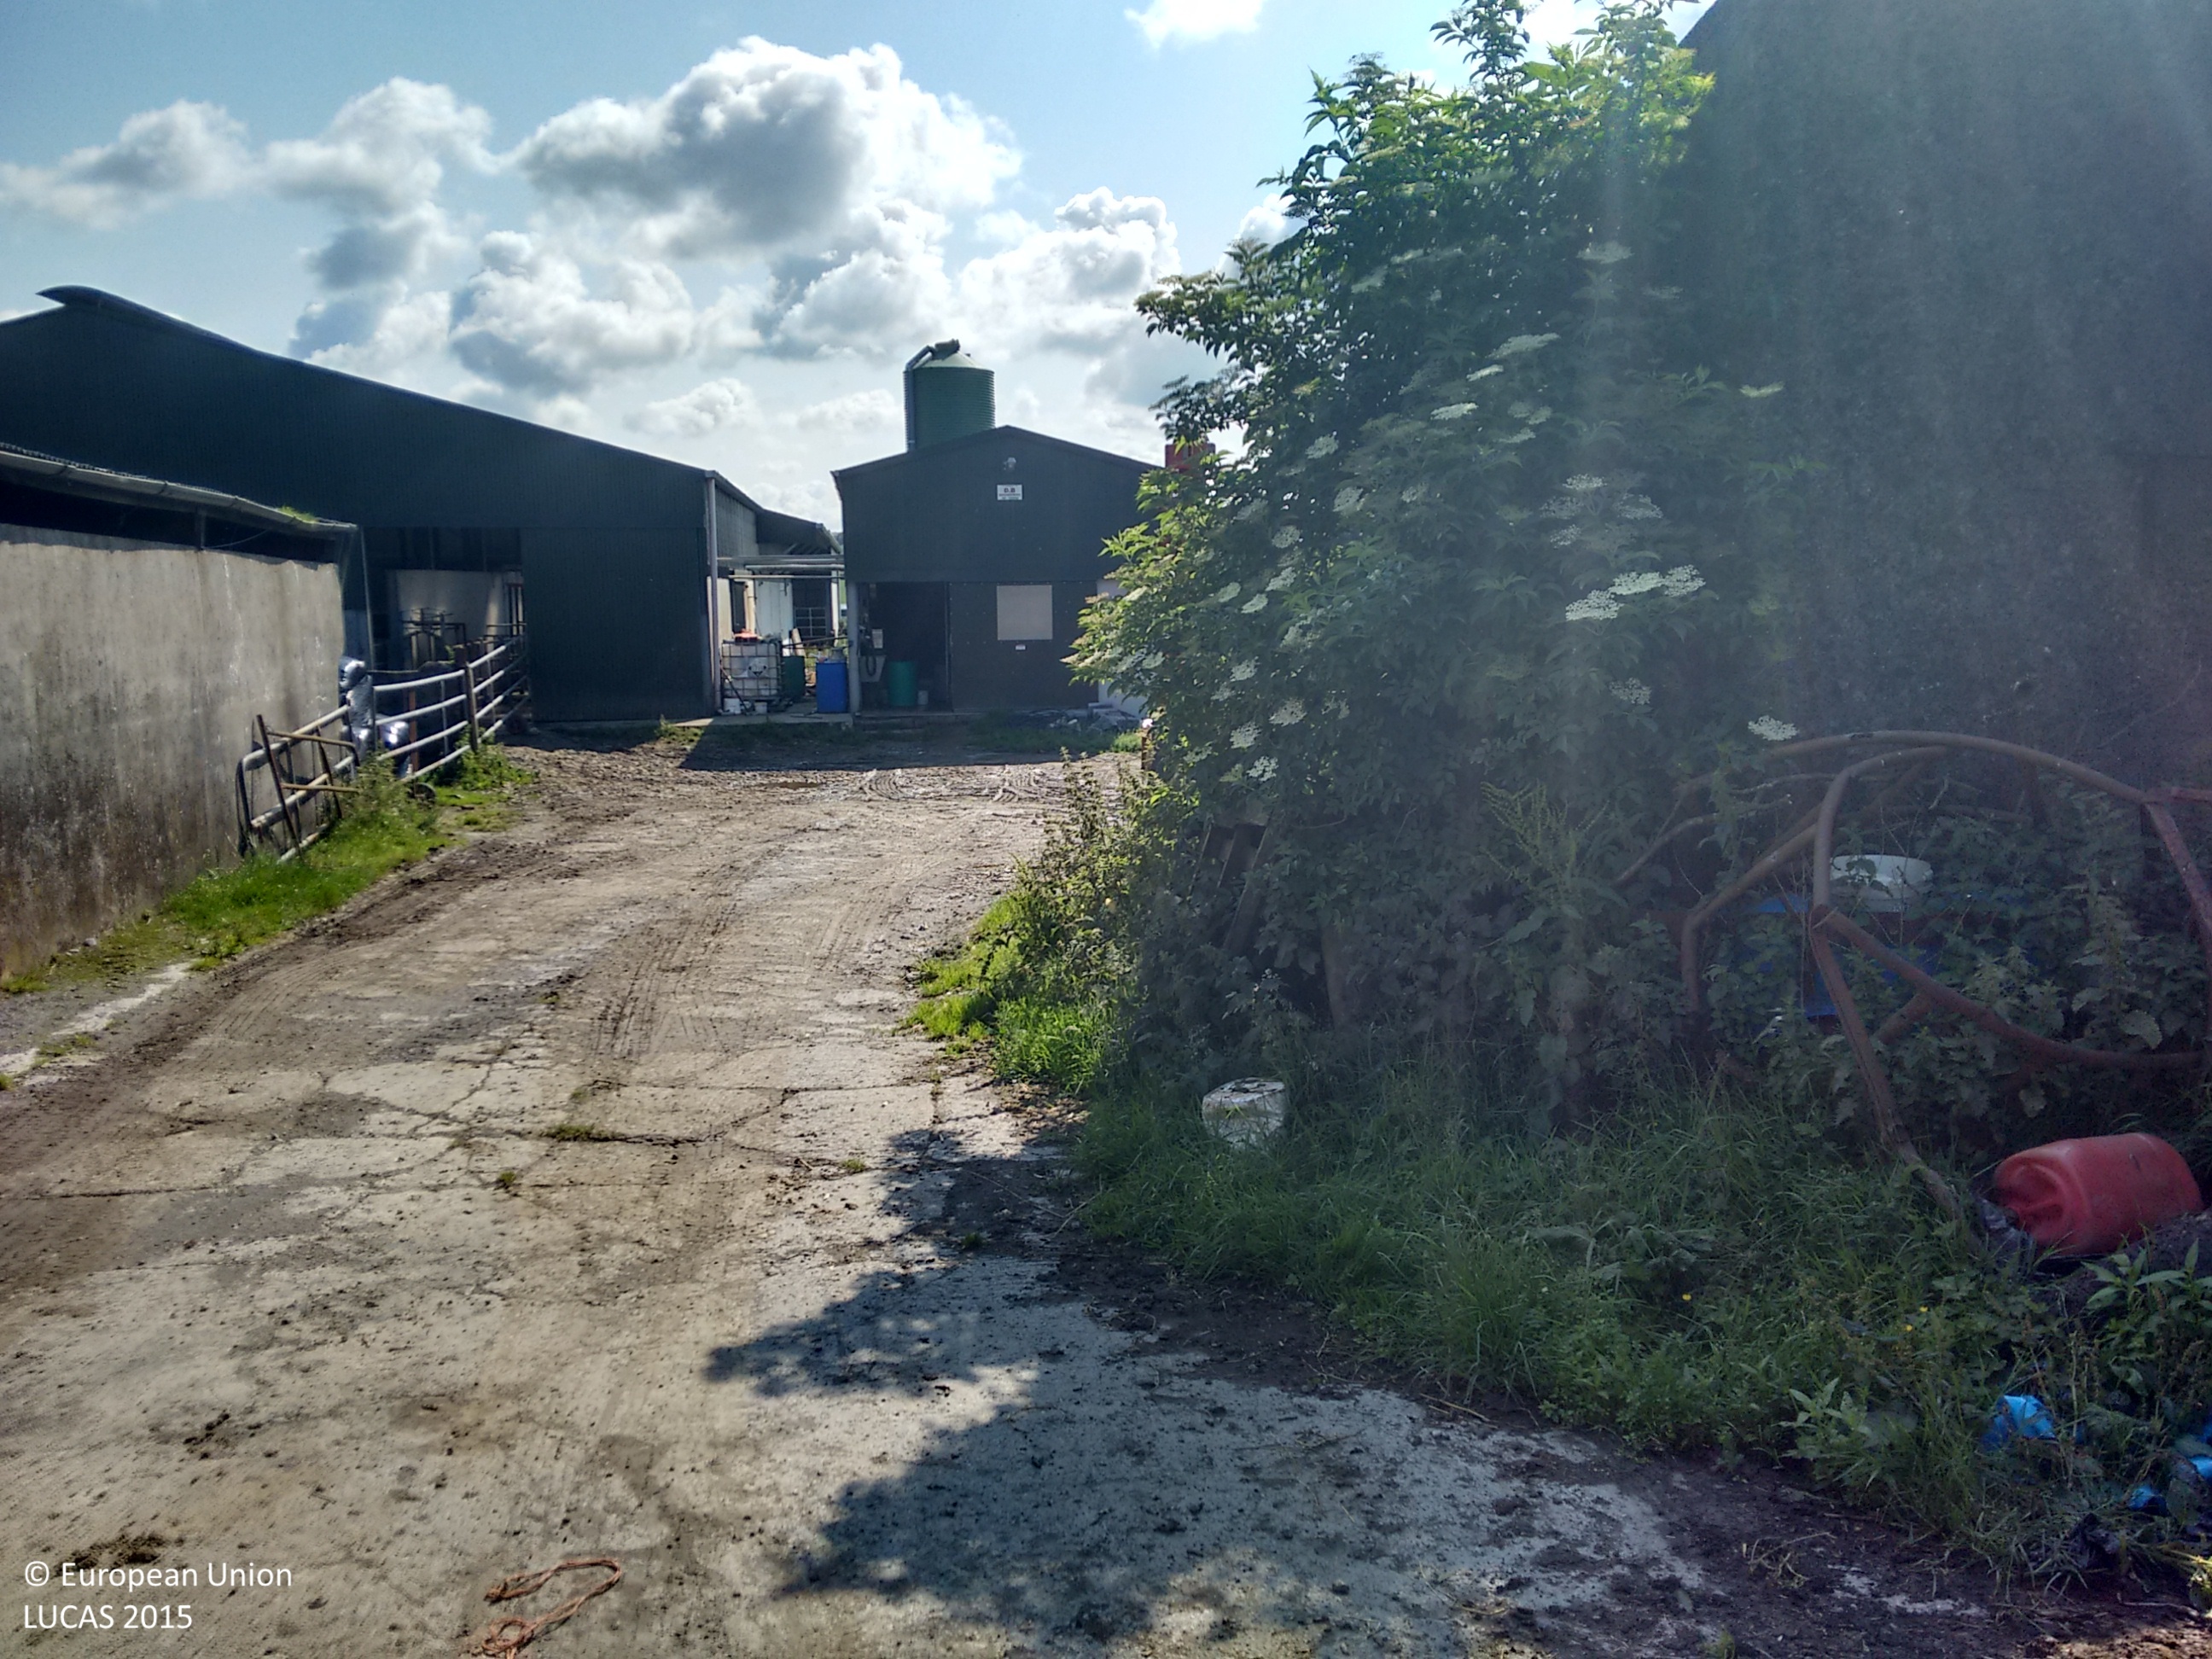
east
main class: Grassland
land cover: Grassland without tree/shrub cover
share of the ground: > 75 %
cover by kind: herbaceous plants 100 %
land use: Agriculture (excluding fallow land and kitchen gardens)
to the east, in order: Grassland without tree/shrub cover; Artificial constructions in urban areas; Grassland without tree/shrub cover; Fences; Abandoned hedges; Electric lines; Grass margins; Paved roads, cycling and walking lanes; Grass margins; Fences; Grassland without tree/shrub cover
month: July
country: IE
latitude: 52.6129
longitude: -7.6042
